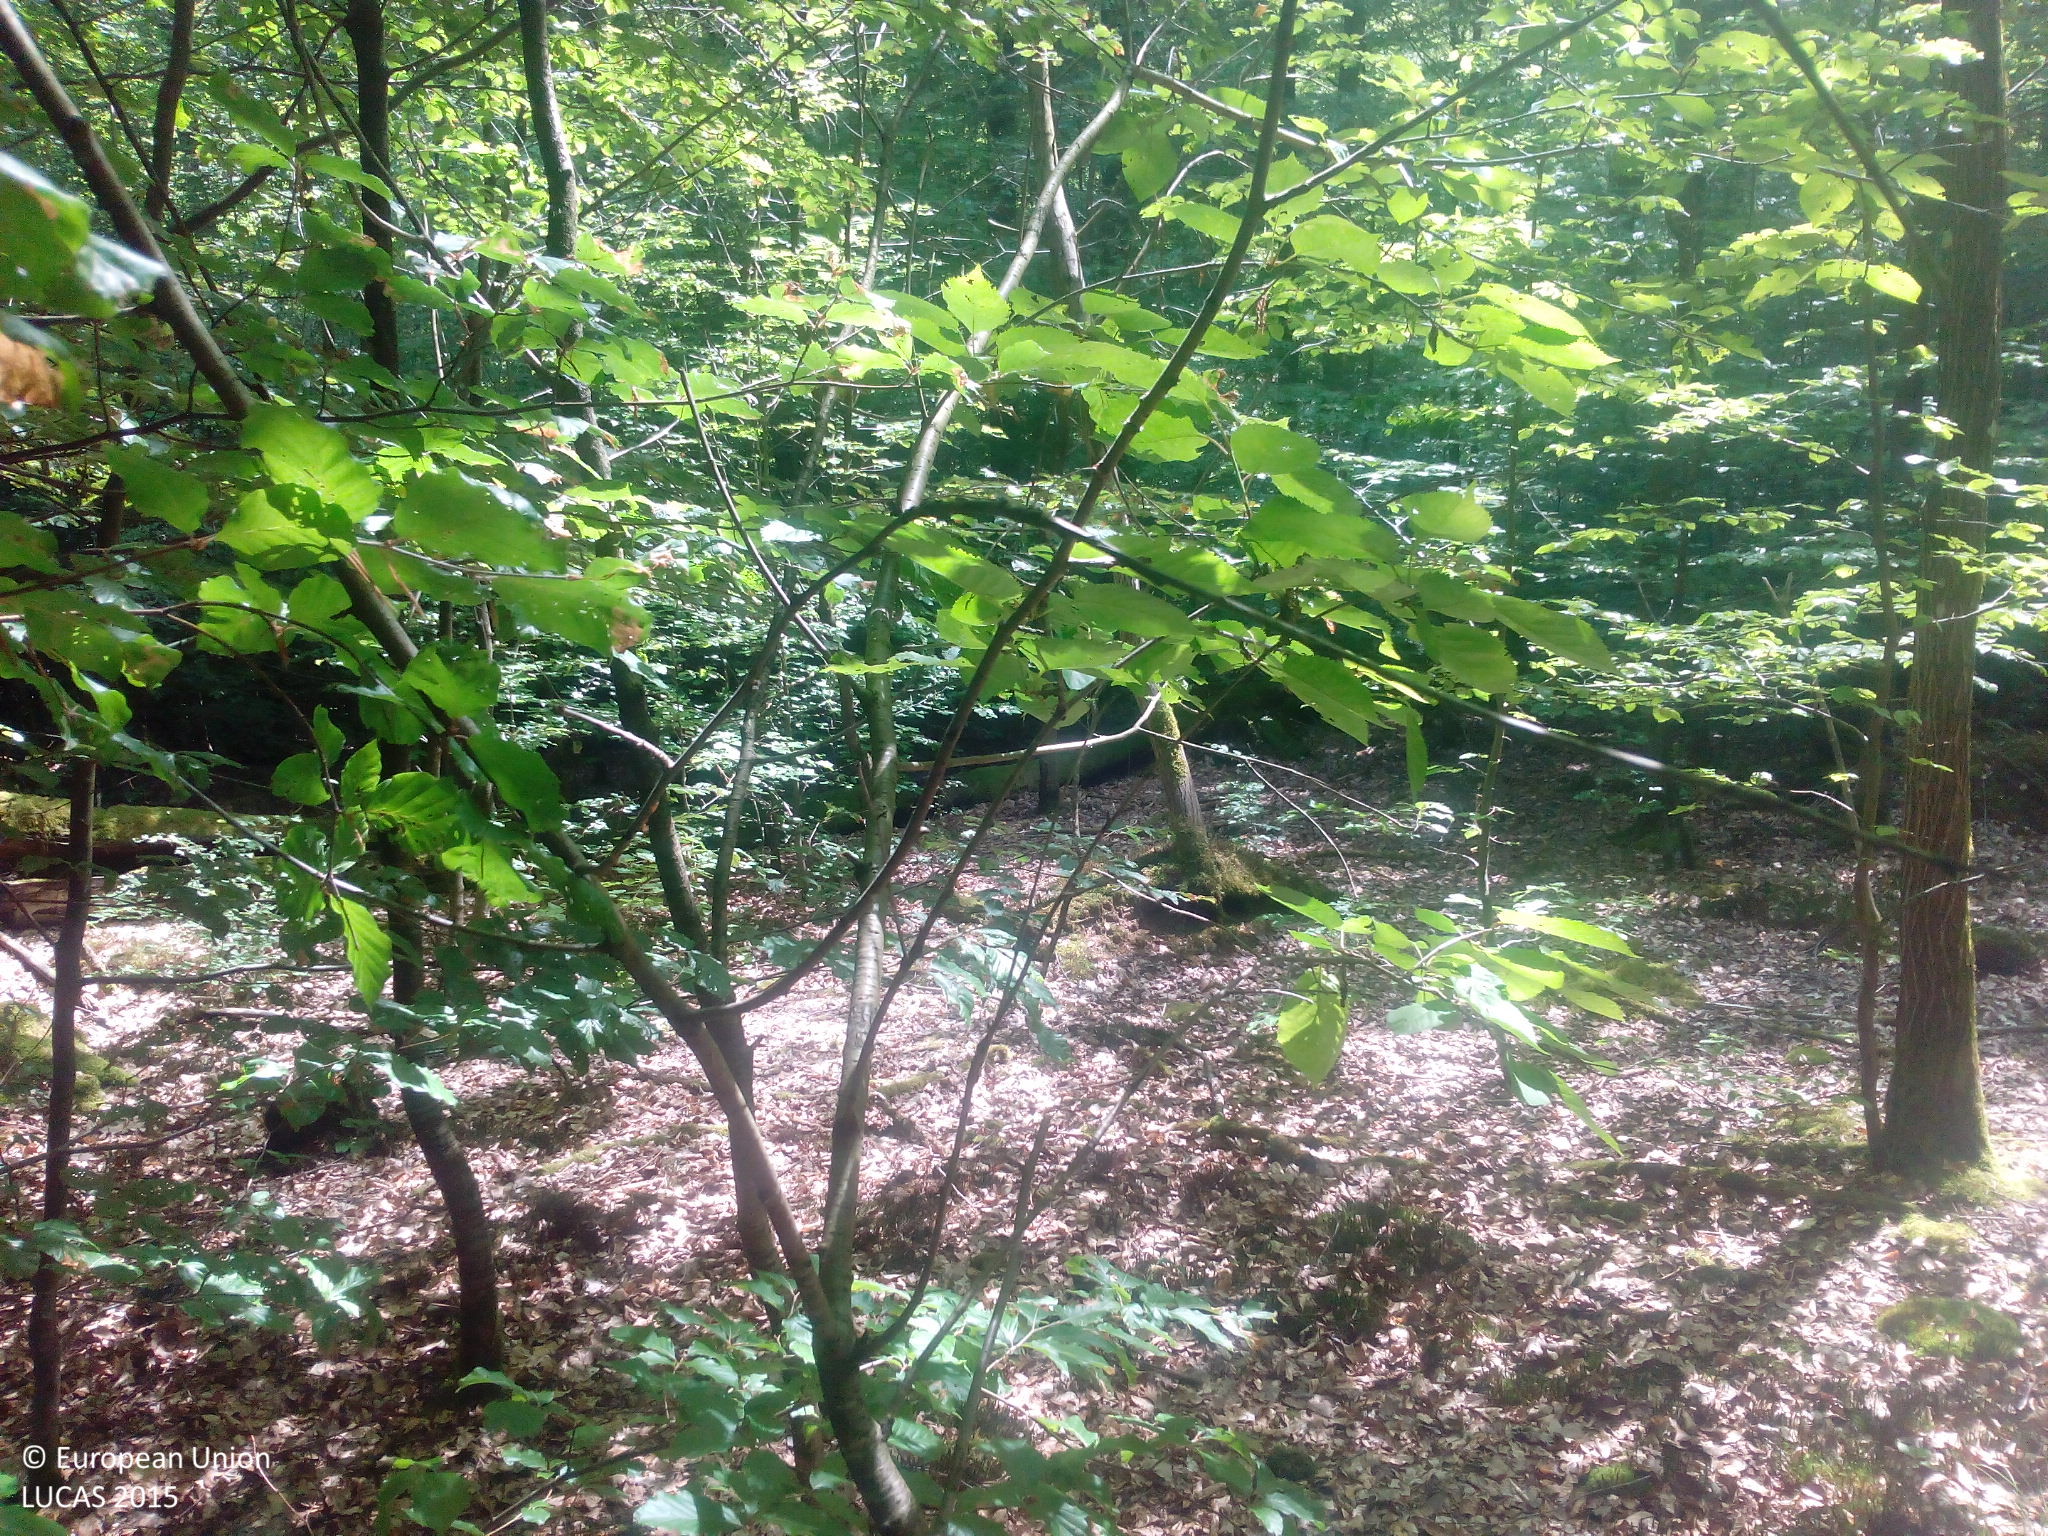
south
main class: Woodland
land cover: Broadleaved woodland
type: mesophytic deciduous forest
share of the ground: > 75 %
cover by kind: broadleaved forest trees 95 %, unconsolidated bare surface 5 %
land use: Forestry
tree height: > 5 m
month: June
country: DE
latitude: 49.9130
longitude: 10.5708
